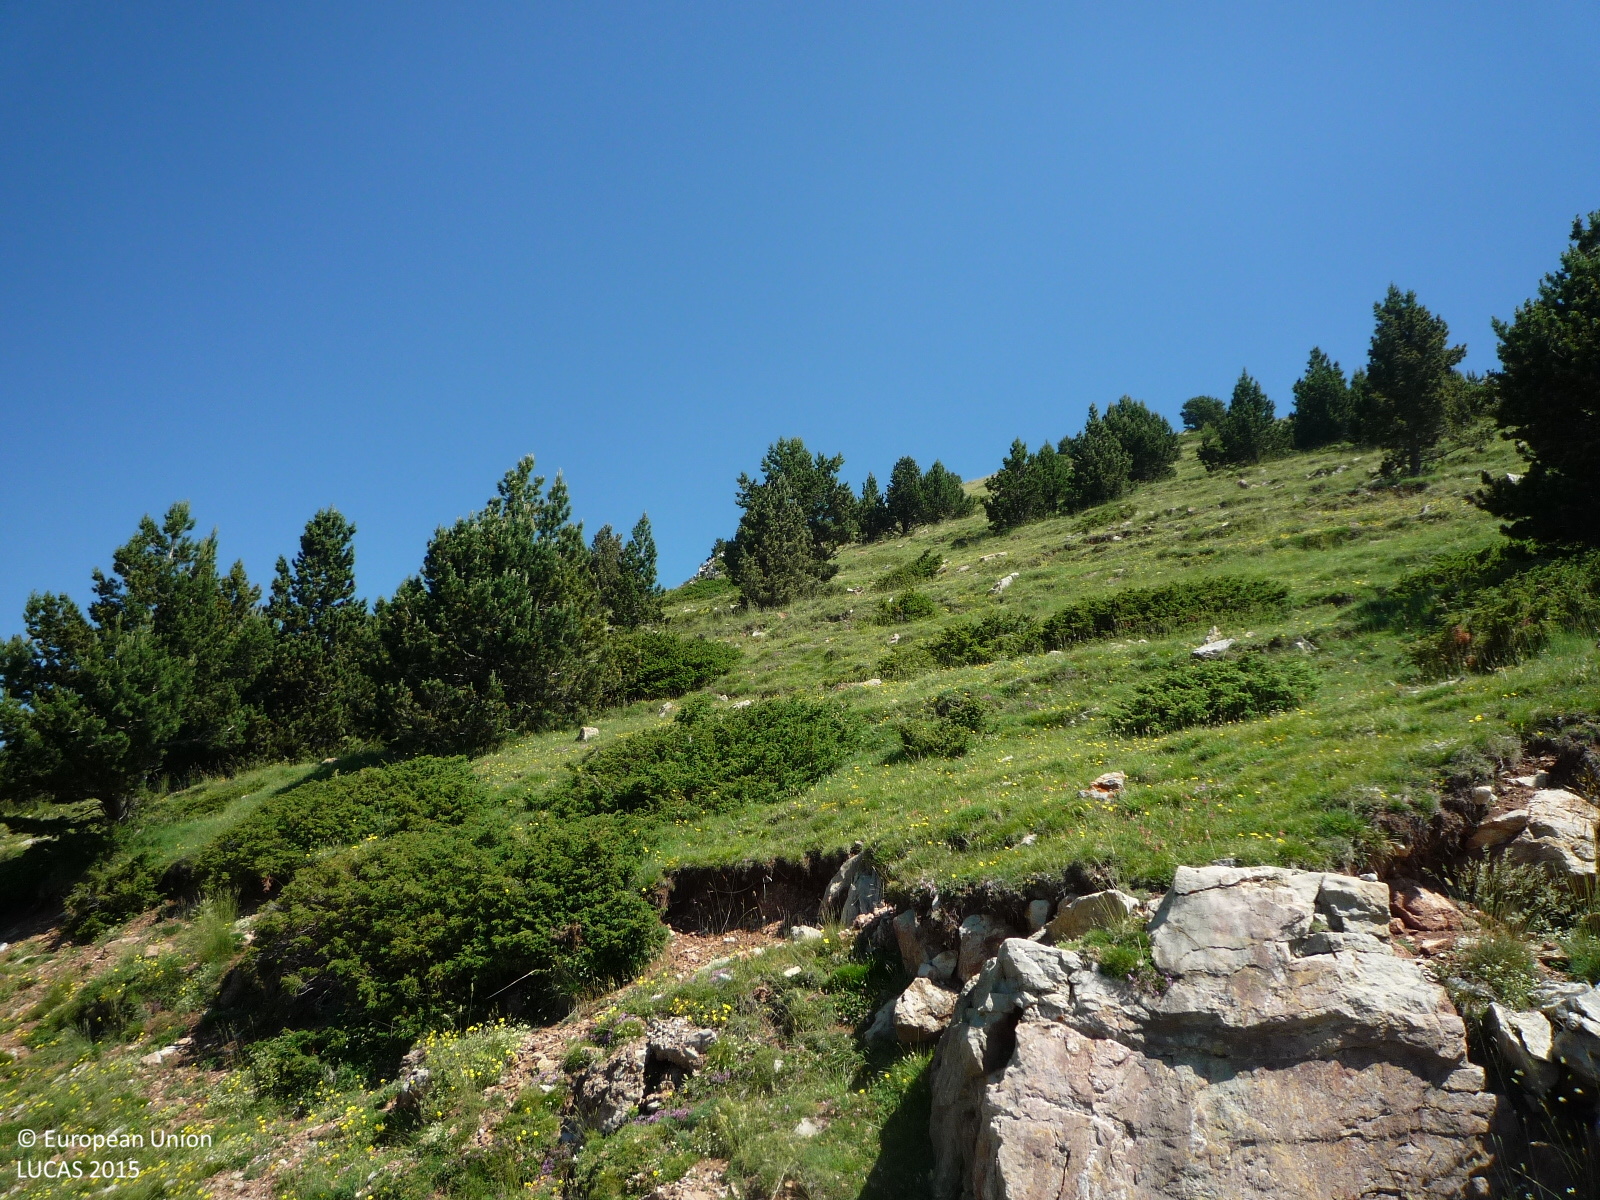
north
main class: Grassland
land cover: Grassland without tree/shrub cover
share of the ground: > 75 %
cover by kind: herbaceous plants 100 %
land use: Semi-natural and natural areas not in use
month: June
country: ES
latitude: 42.2966
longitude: 1.9460
